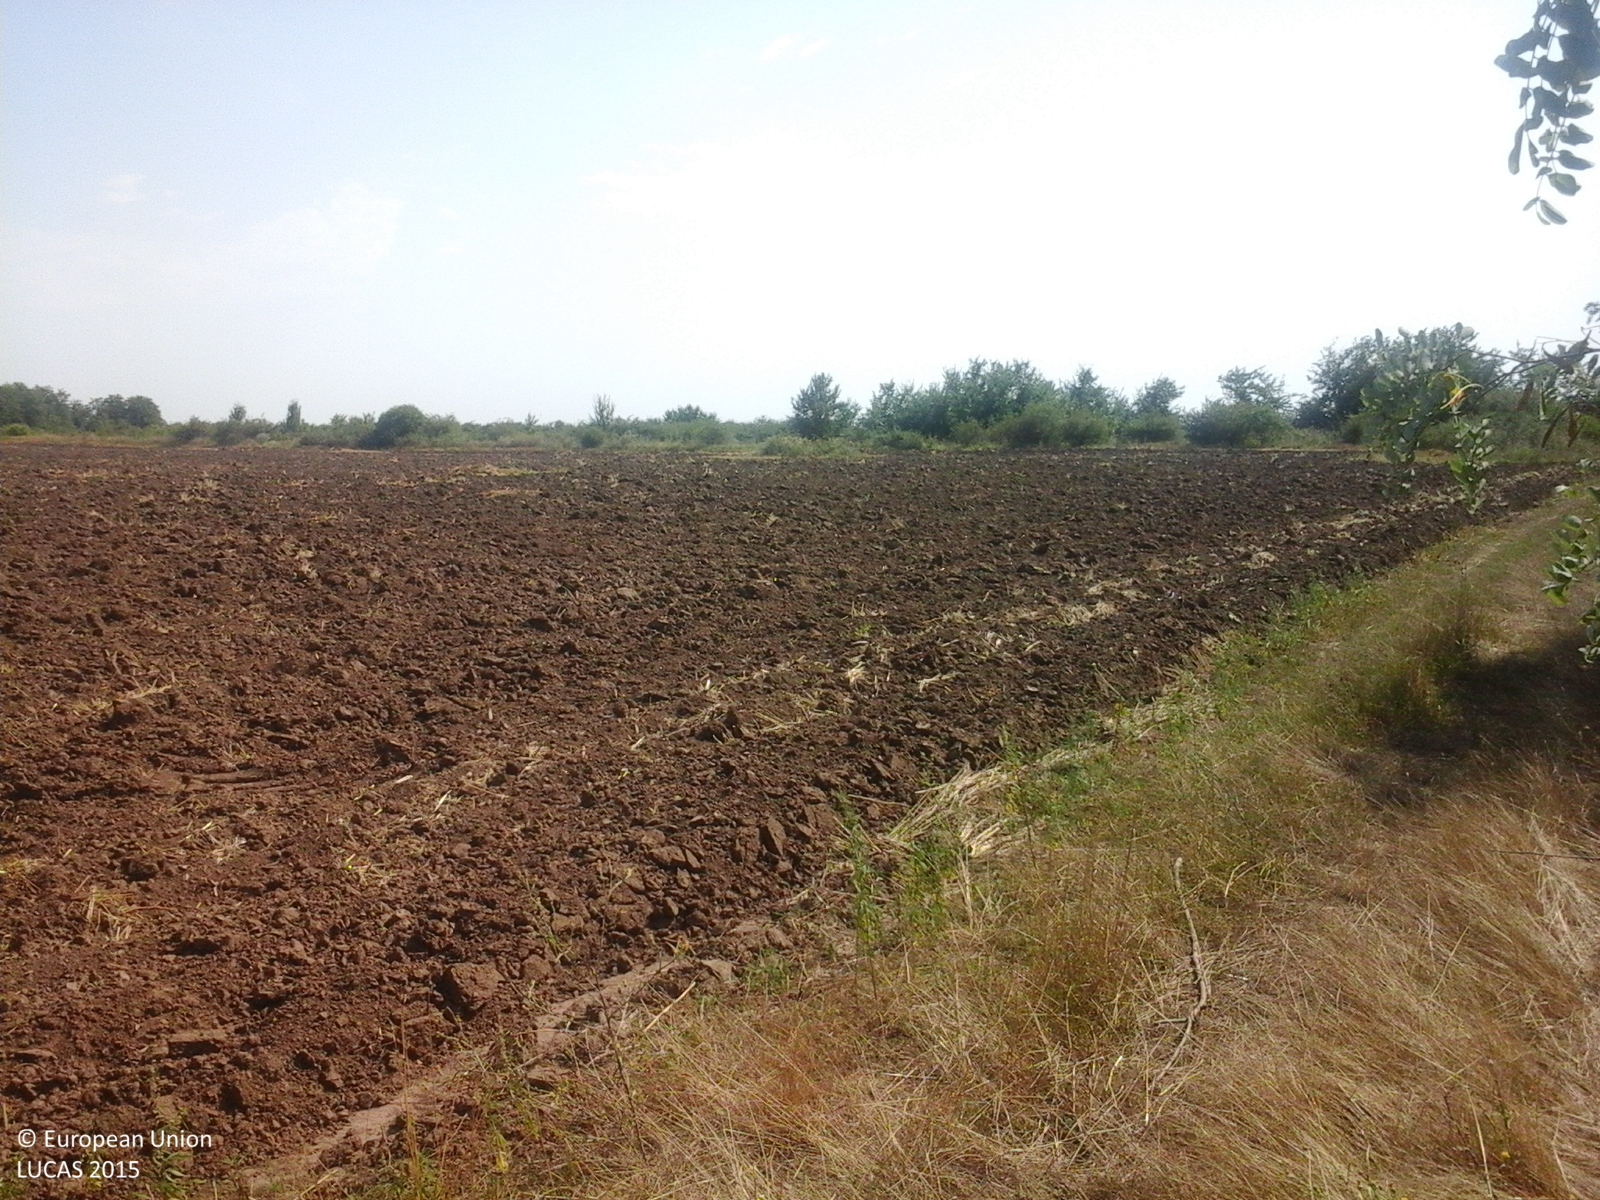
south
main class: Woodland
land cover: Broadleaved woodland
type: exotic forest
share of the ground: > 75 %
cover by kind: broadleaved forest trees 100 %
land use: Forestry
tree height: > 5 m
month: August
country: RO
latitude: 43.9881
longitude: 27.9424
